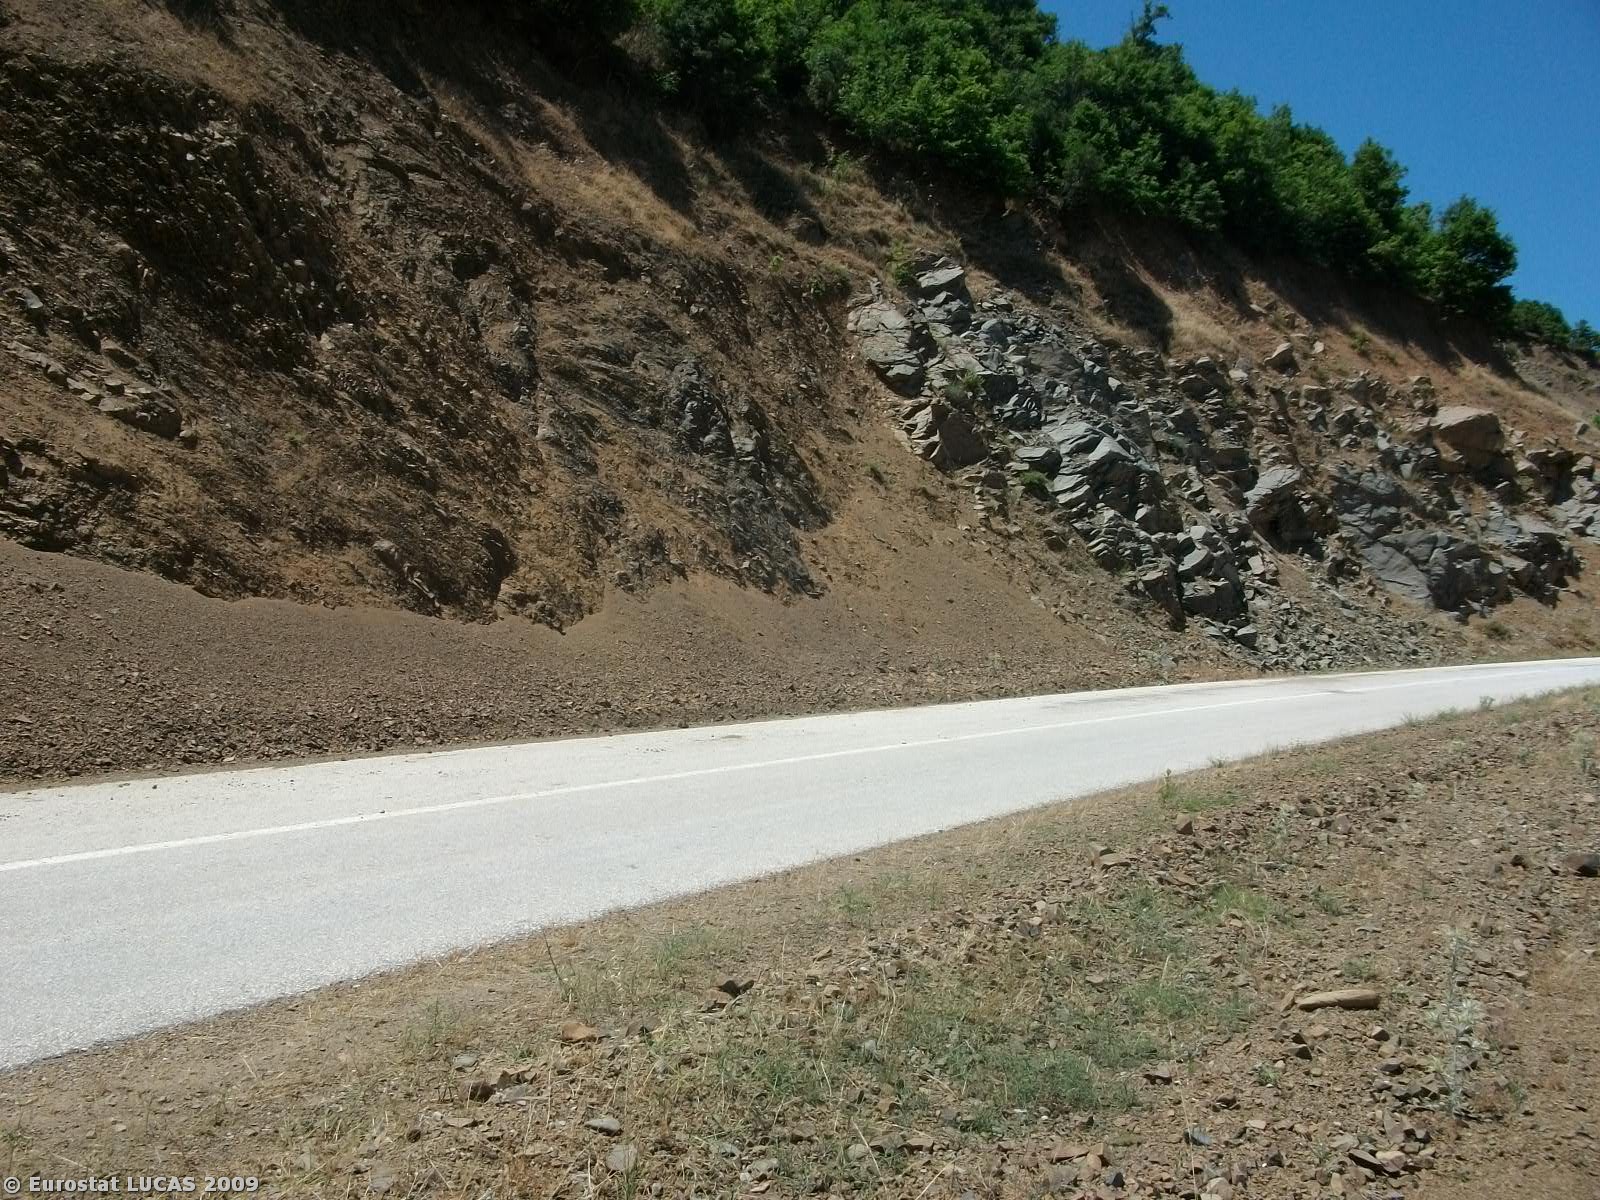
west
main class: Woodland
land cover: Broadleaved woodland
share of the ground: > 75 %
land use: Forestry
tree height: < 5 m
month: July
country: GR
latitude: 39.1910
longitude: 21.9170
